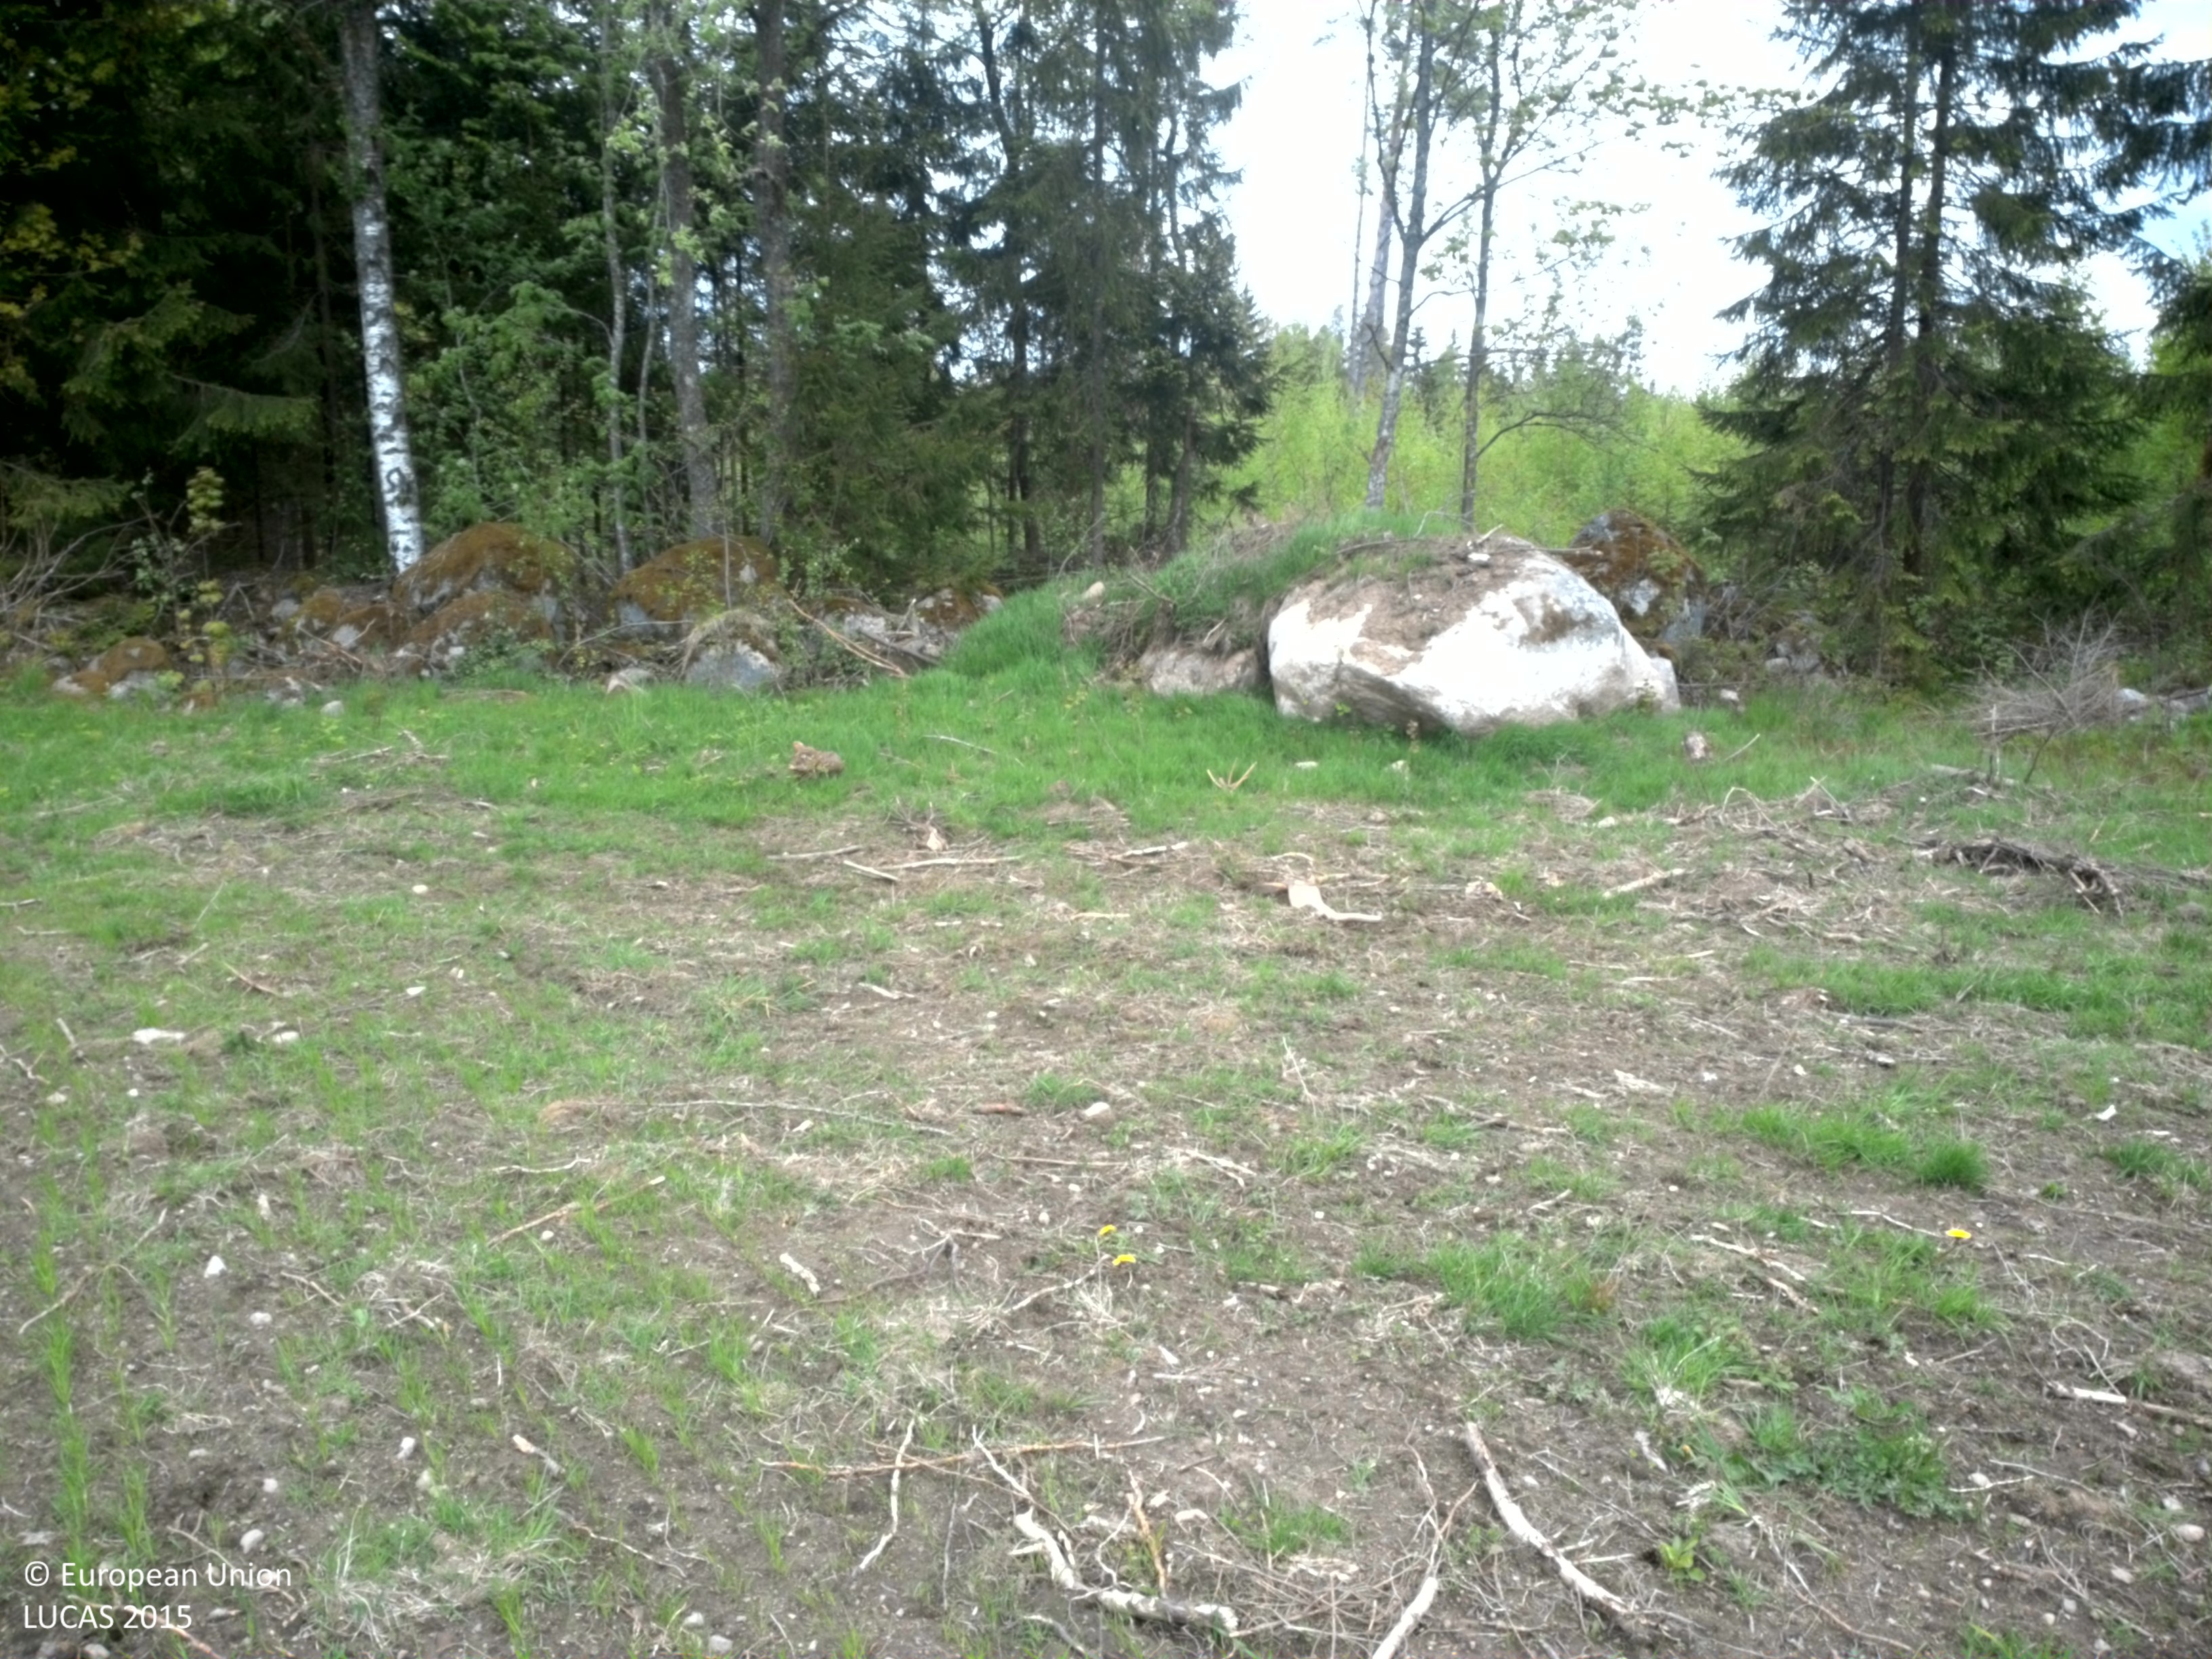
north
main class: Cropland
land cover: Other leguminous and mixtures for fodder
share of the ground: 25 - 50 %
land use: Agriculture (excluding fallow land and kitchen gardens)
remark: Tilled/Sowed
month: May
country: SE
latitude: 56.5322
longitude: 15.2176
